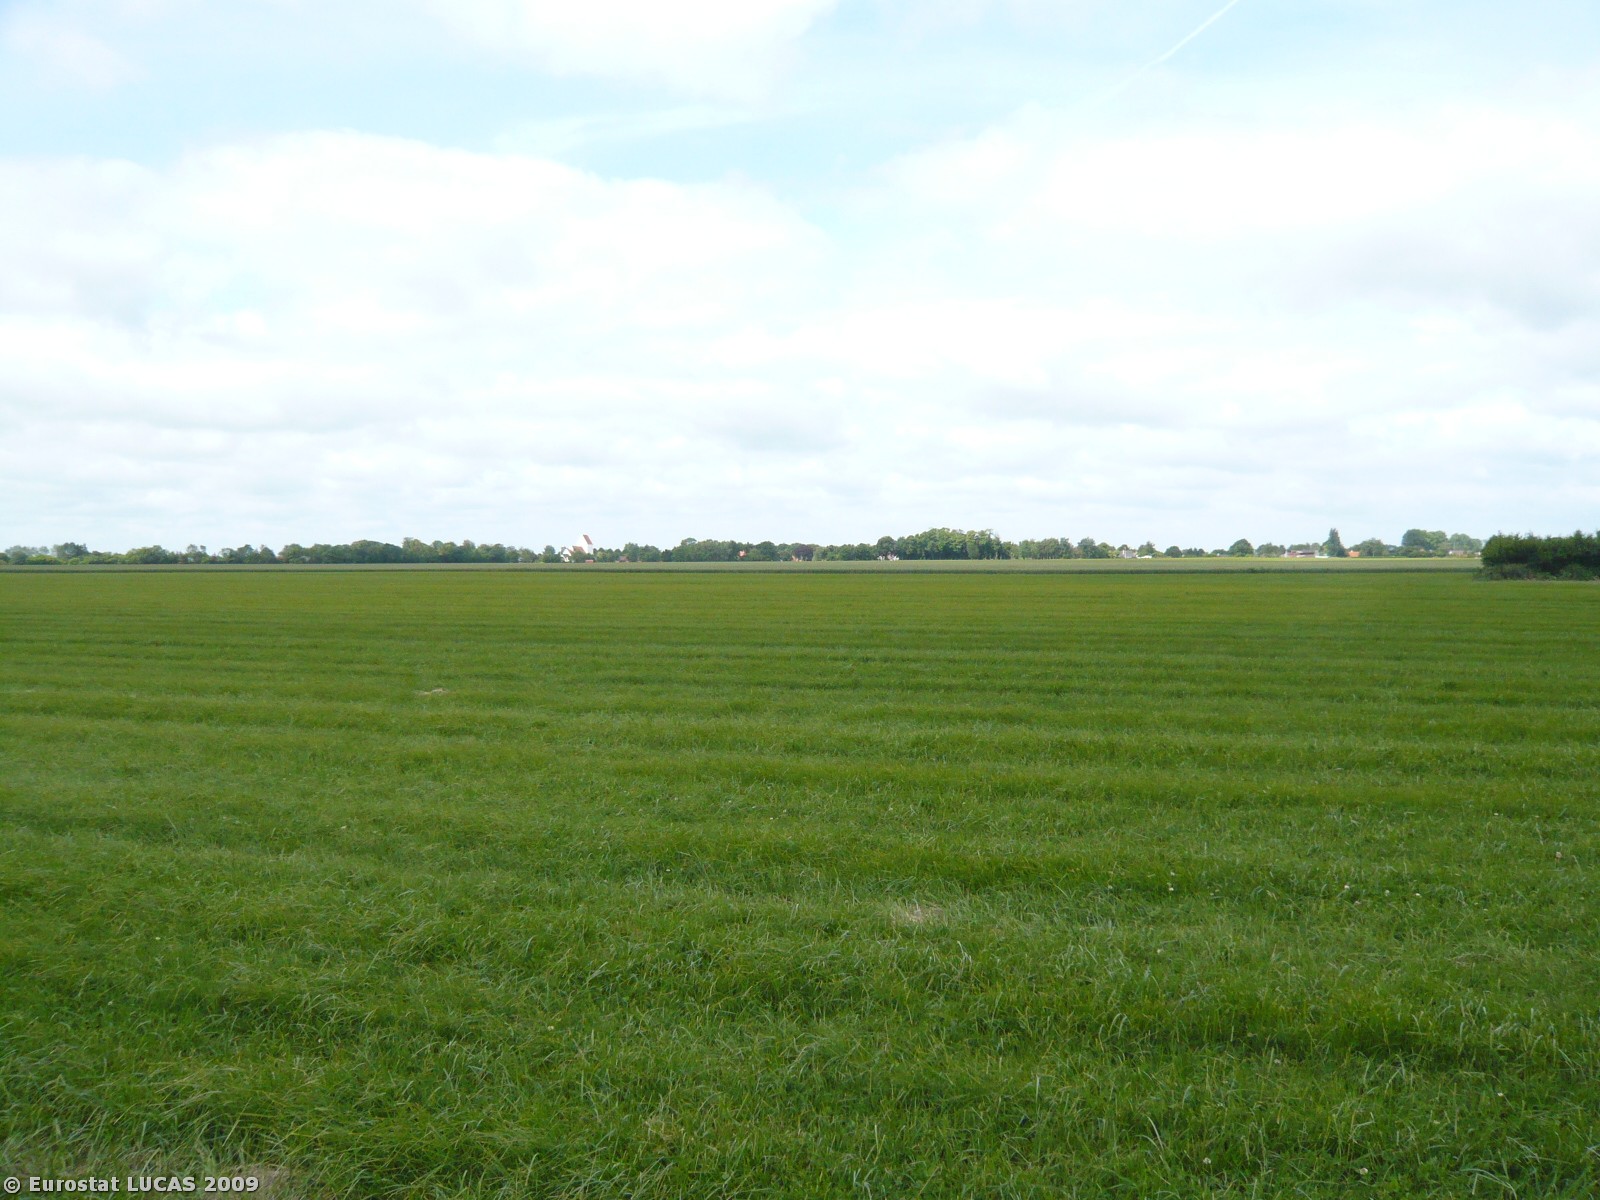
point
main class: Cropland
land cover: Common wheat
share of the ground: > 75 %
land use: Agriculture (excluding fallow land and kitchen gardens)
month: June
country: DK
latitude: 54.9238
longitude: 11.2006
